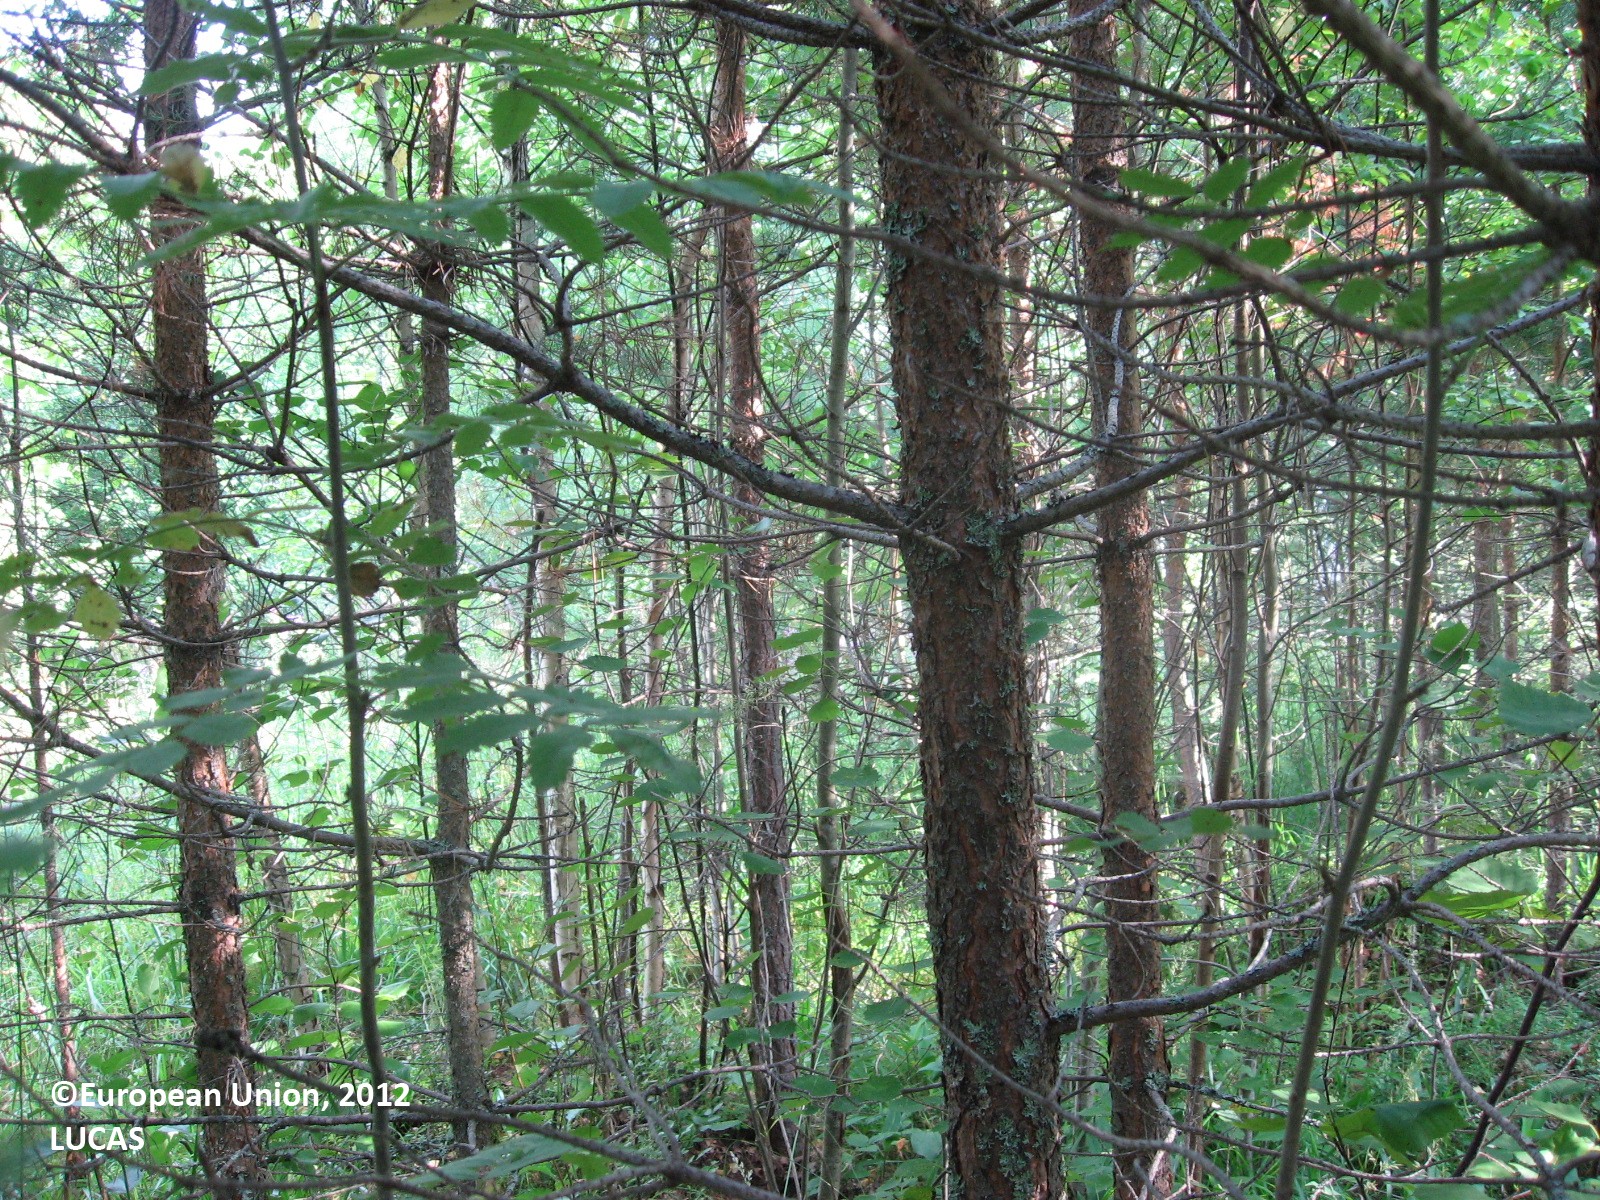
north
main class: Woodland
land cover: Pine dominated mixed woodland
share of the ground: > 75 %
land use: Forestry
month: August
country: FI
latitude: 61.4758
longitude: 25.9578
